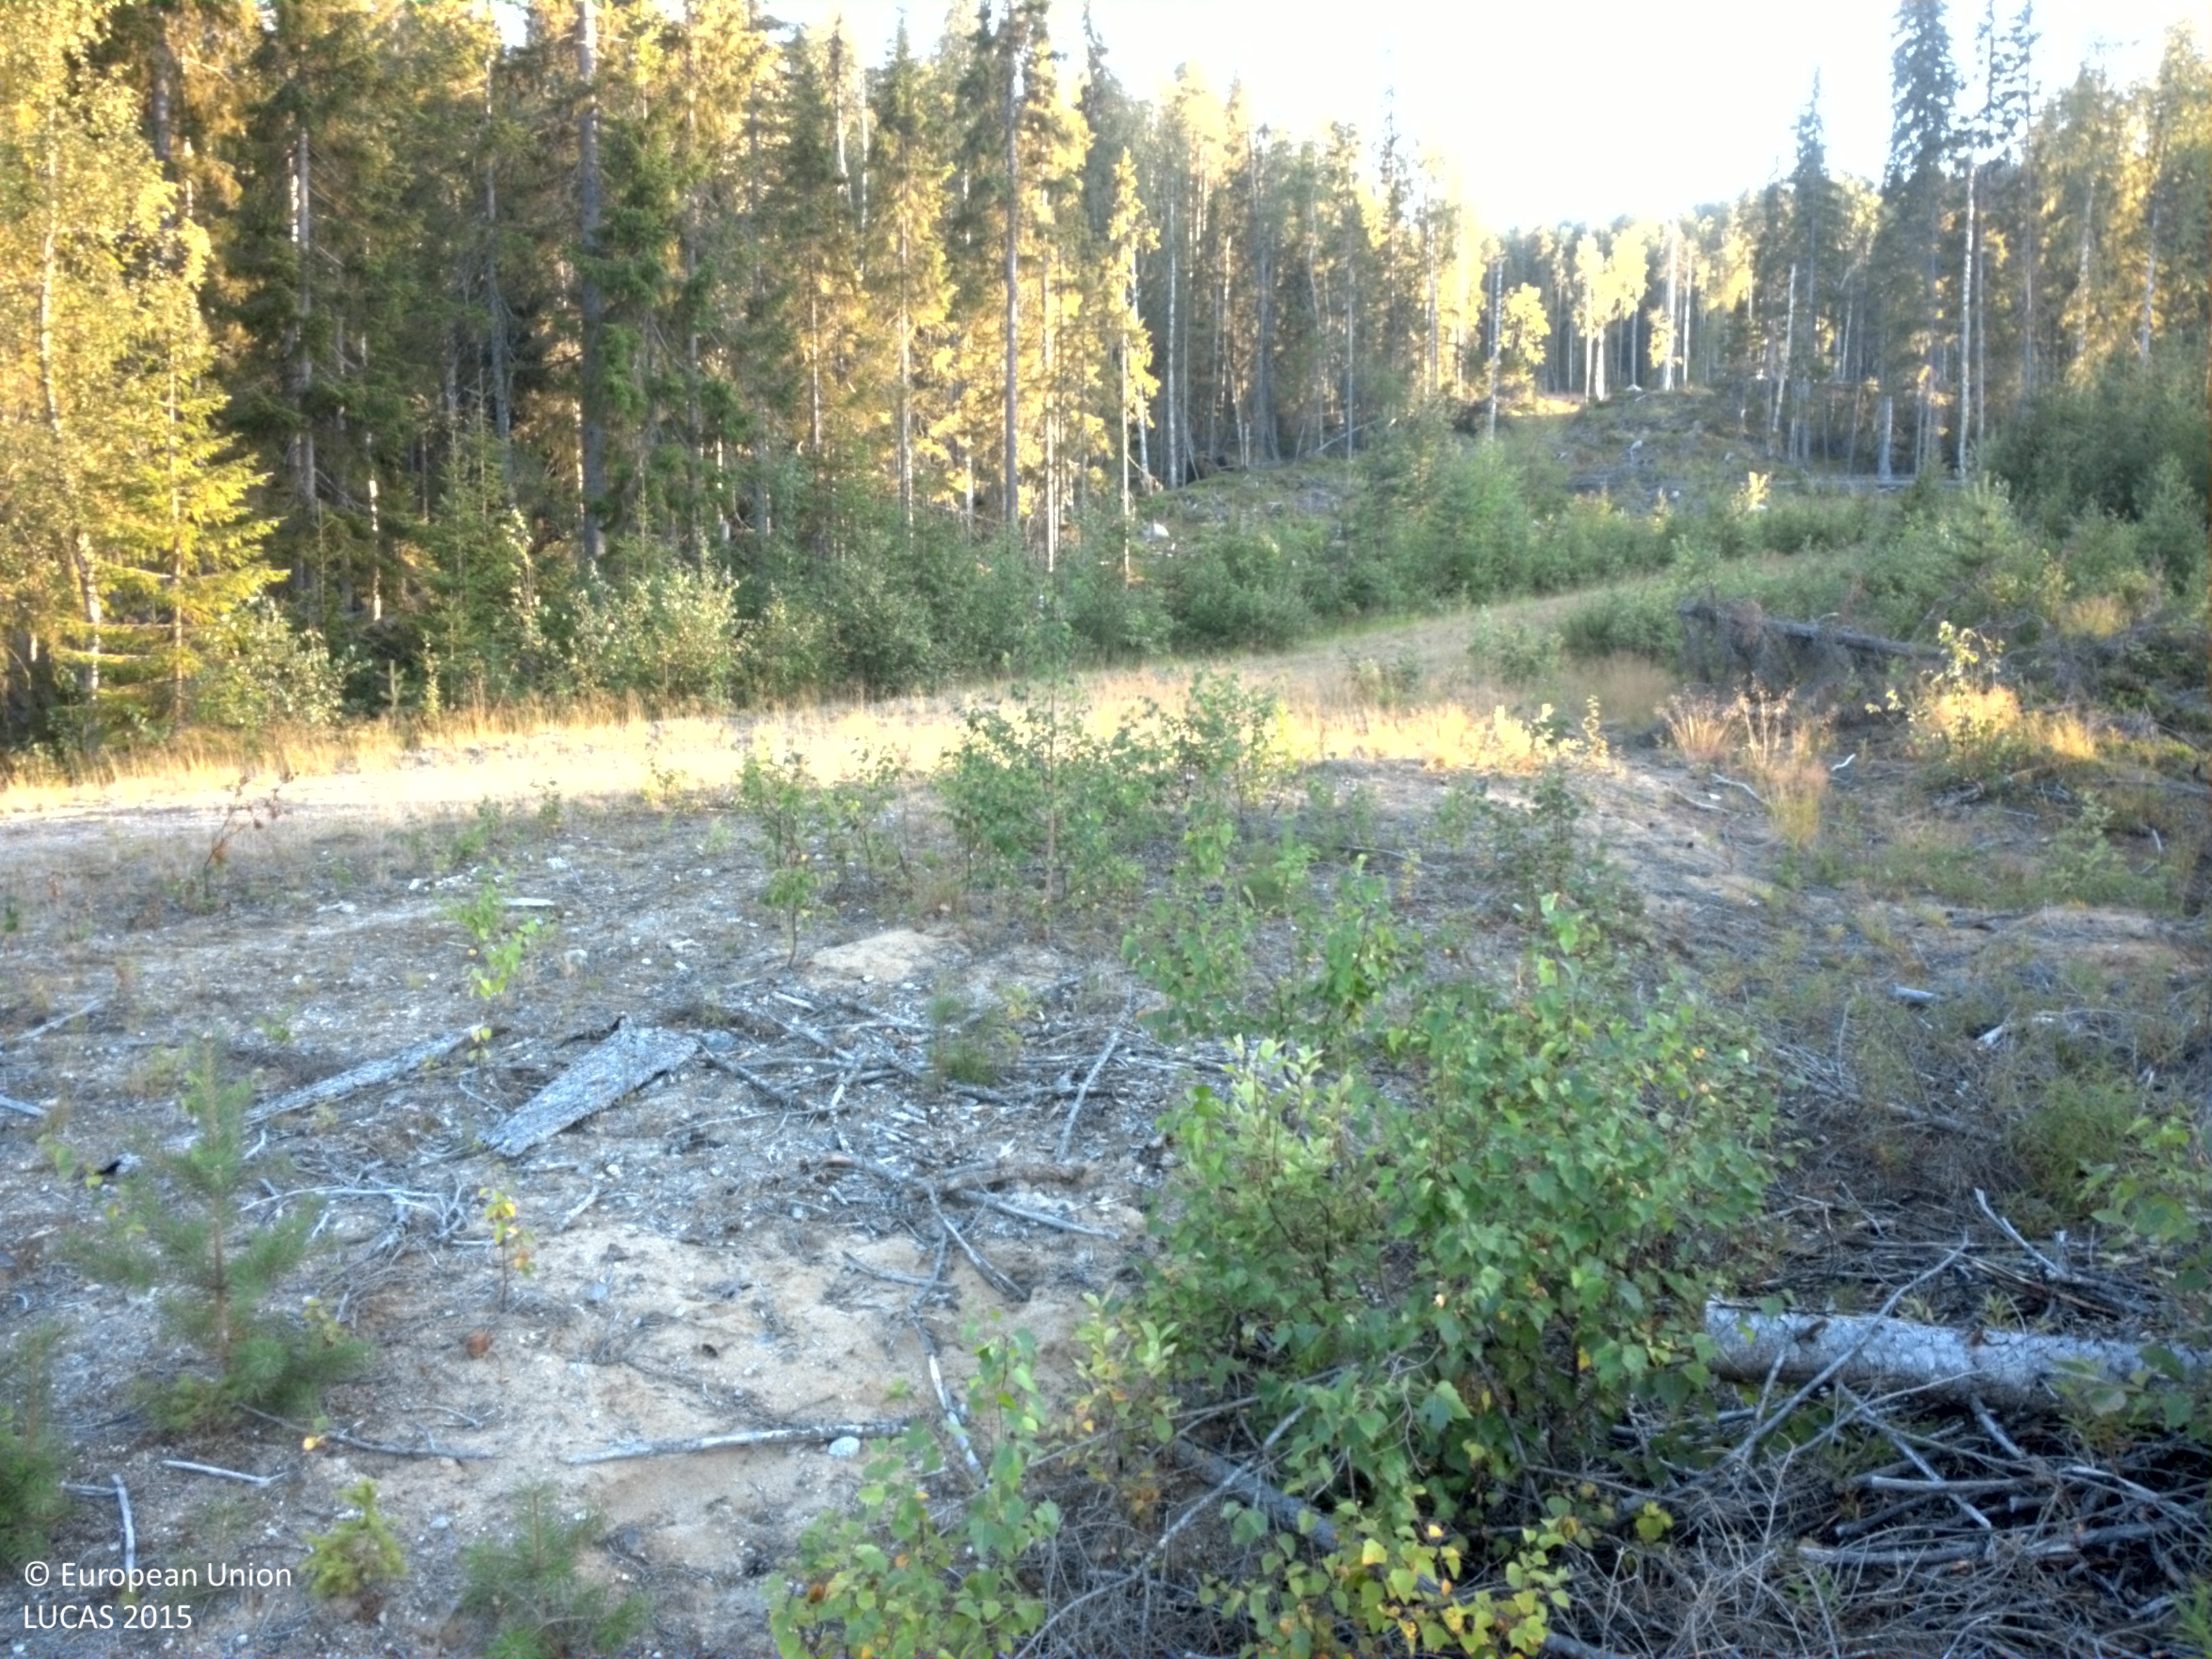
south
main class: Woodland
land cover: Other mixed woodland
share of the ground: 10 - 25 %
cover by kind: unconsolidated bare surface 60 %, herbaceous plants 20 %, broadleaved forest trees 10 %, coniferous forest trees 5 %, shrubs 5 %
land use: Forestry
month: August
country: SE
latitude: 64.4153
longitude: 18.9985
